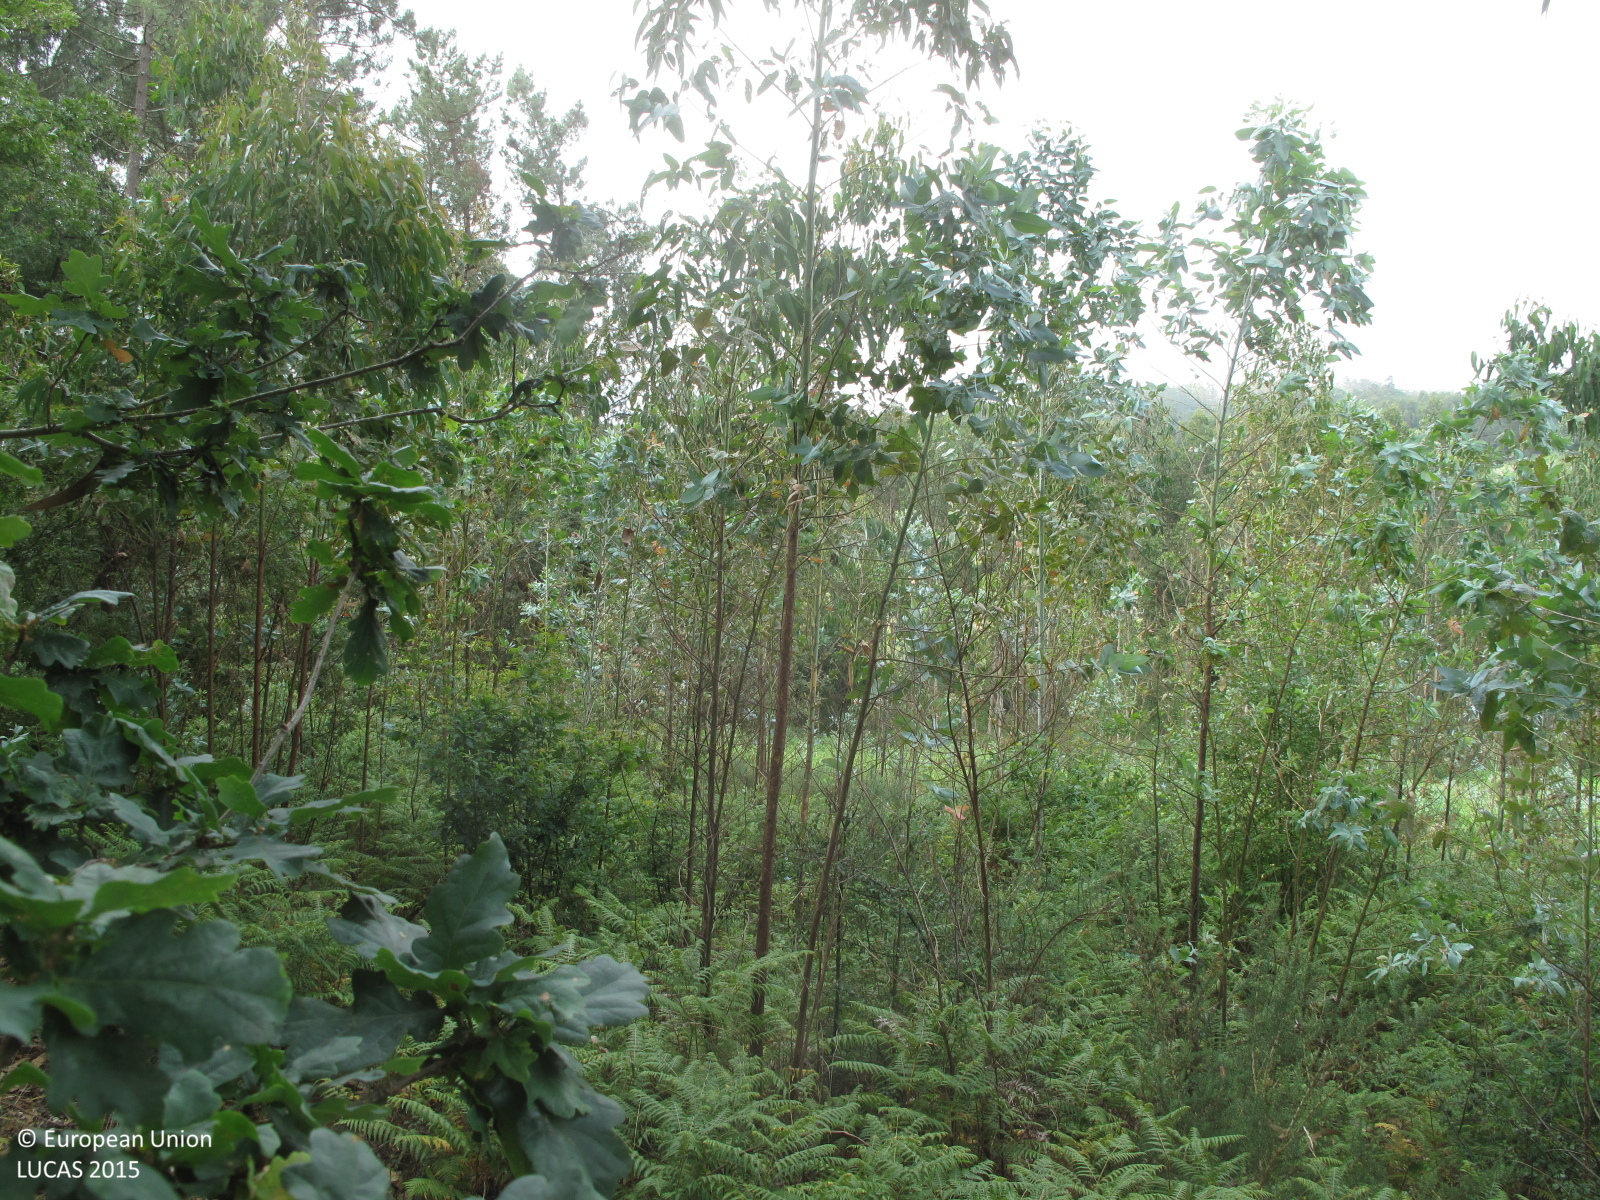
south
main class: Woodland
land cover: Broadleaved woodland
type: exotic forest
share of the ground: 50 - 75 %
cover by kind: broadleaved forest trees 60 %, shrubs 20 %, herbaceous plants 20 %
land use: Forestry
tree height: > 5 m
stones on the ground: 10 - 25 %
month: July
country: ES
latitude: 43.3257
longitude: -8.2417
